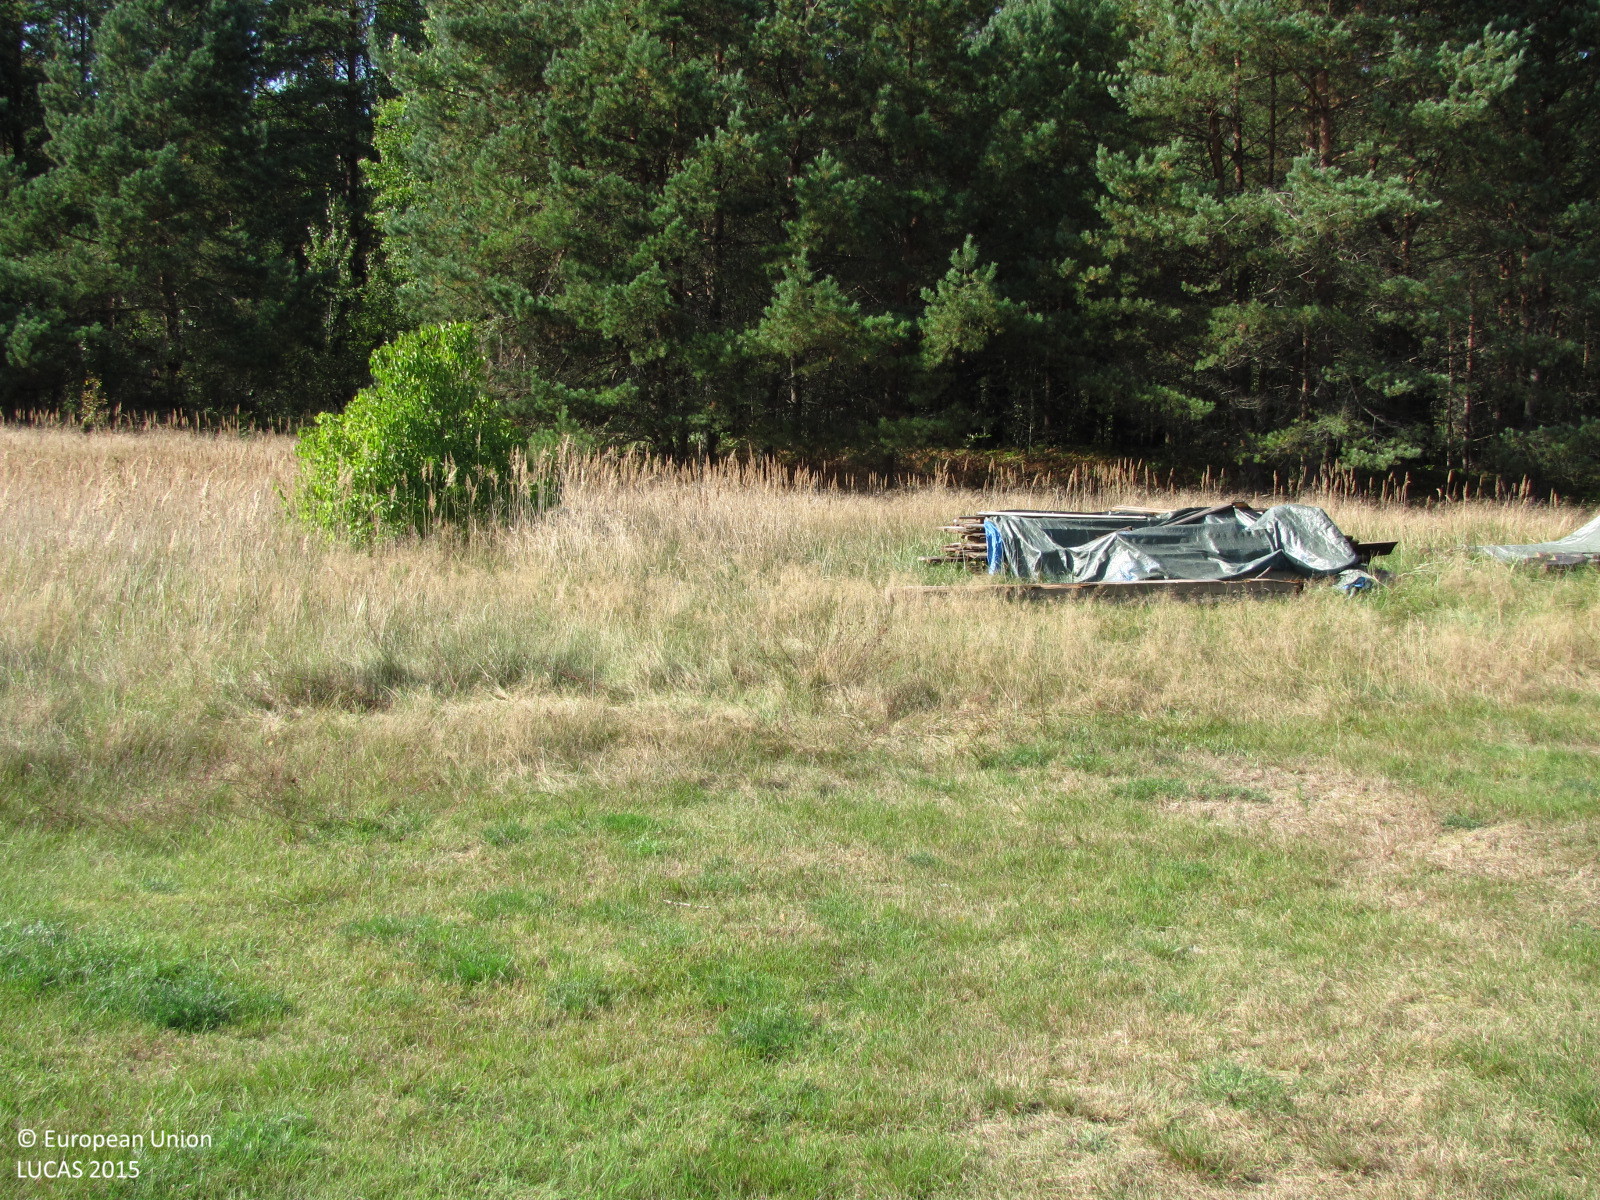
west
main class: Grassland
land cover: Grassland without tree/shrub cover
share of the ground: > 75 %
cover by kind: herbaceous plants 100 %
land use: Residential
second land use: Amenities, museums, leisure
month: September
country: LV
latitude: 57.1326
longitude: 24.3477
